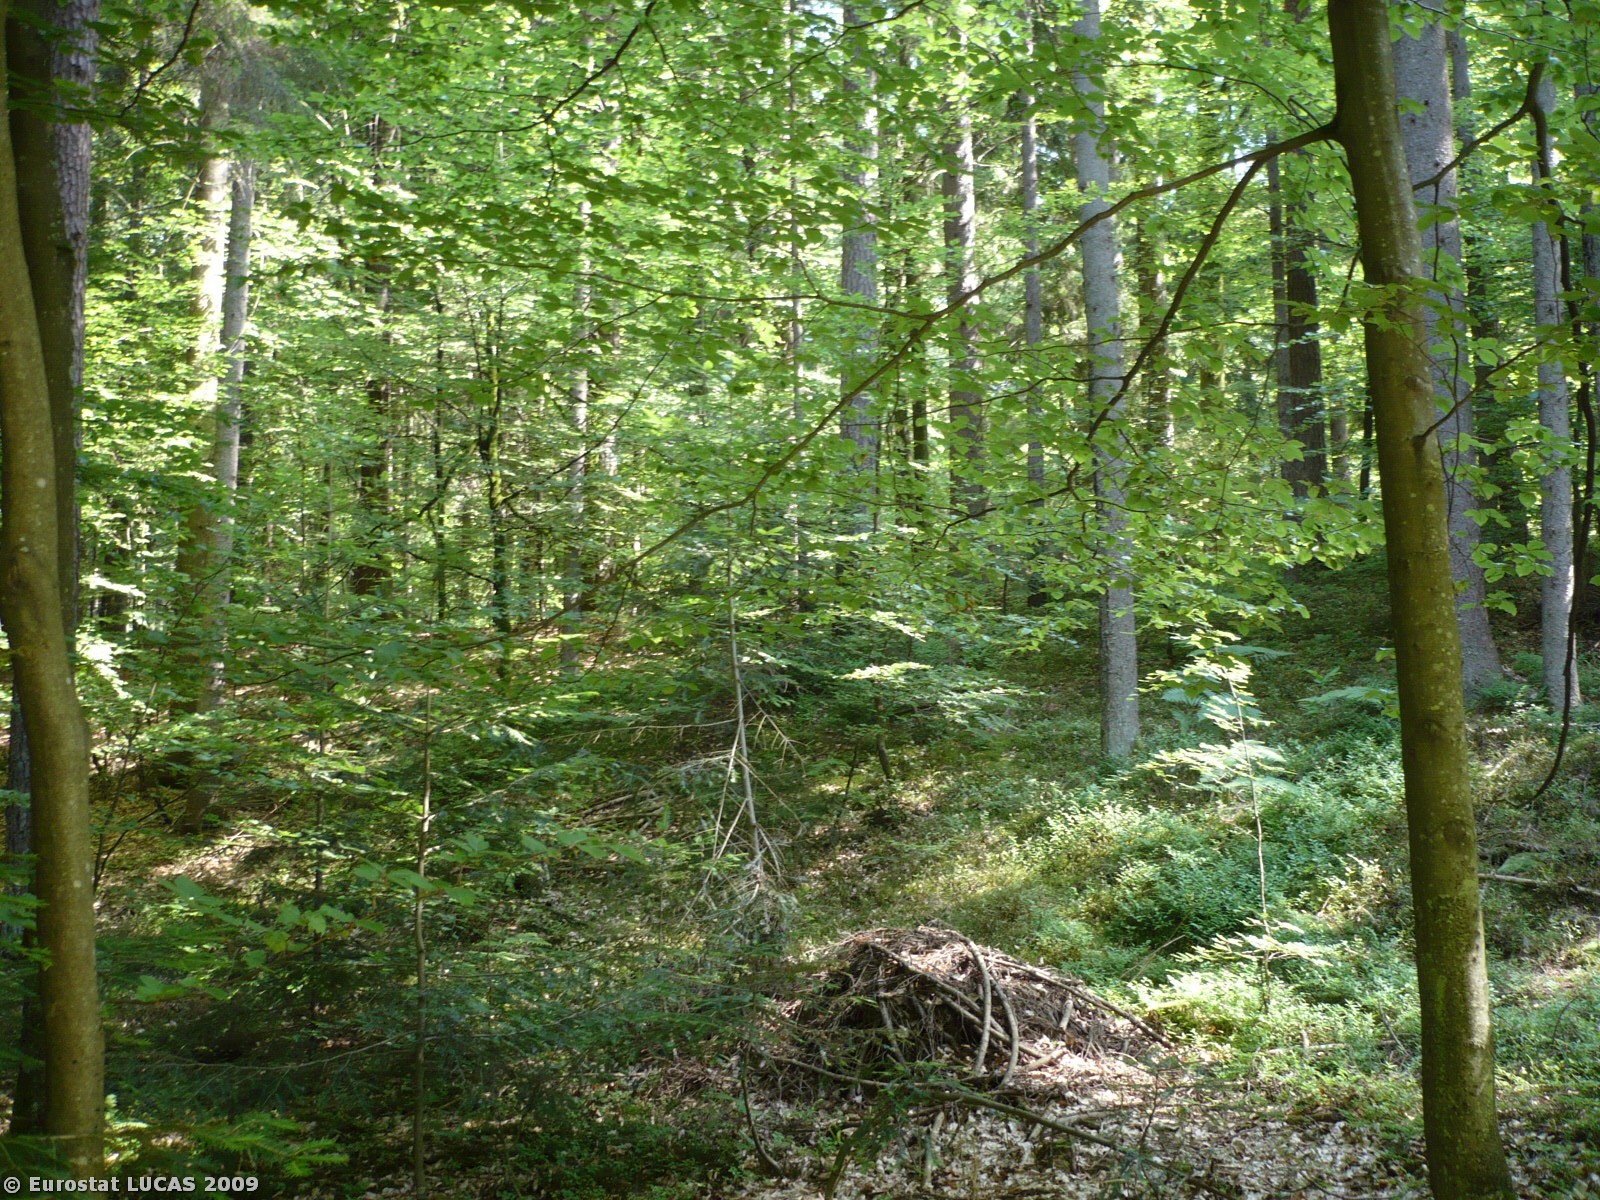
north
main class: Woodland
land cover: Mixed woodland
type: hemiboreal forest and nemoral coniferous forest and mixed broadleaved-coniferous forest
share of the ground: > 75 %
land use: Forestry
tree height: > 5 m
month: May
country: SI
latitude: 46.2852
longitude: 14.2410
